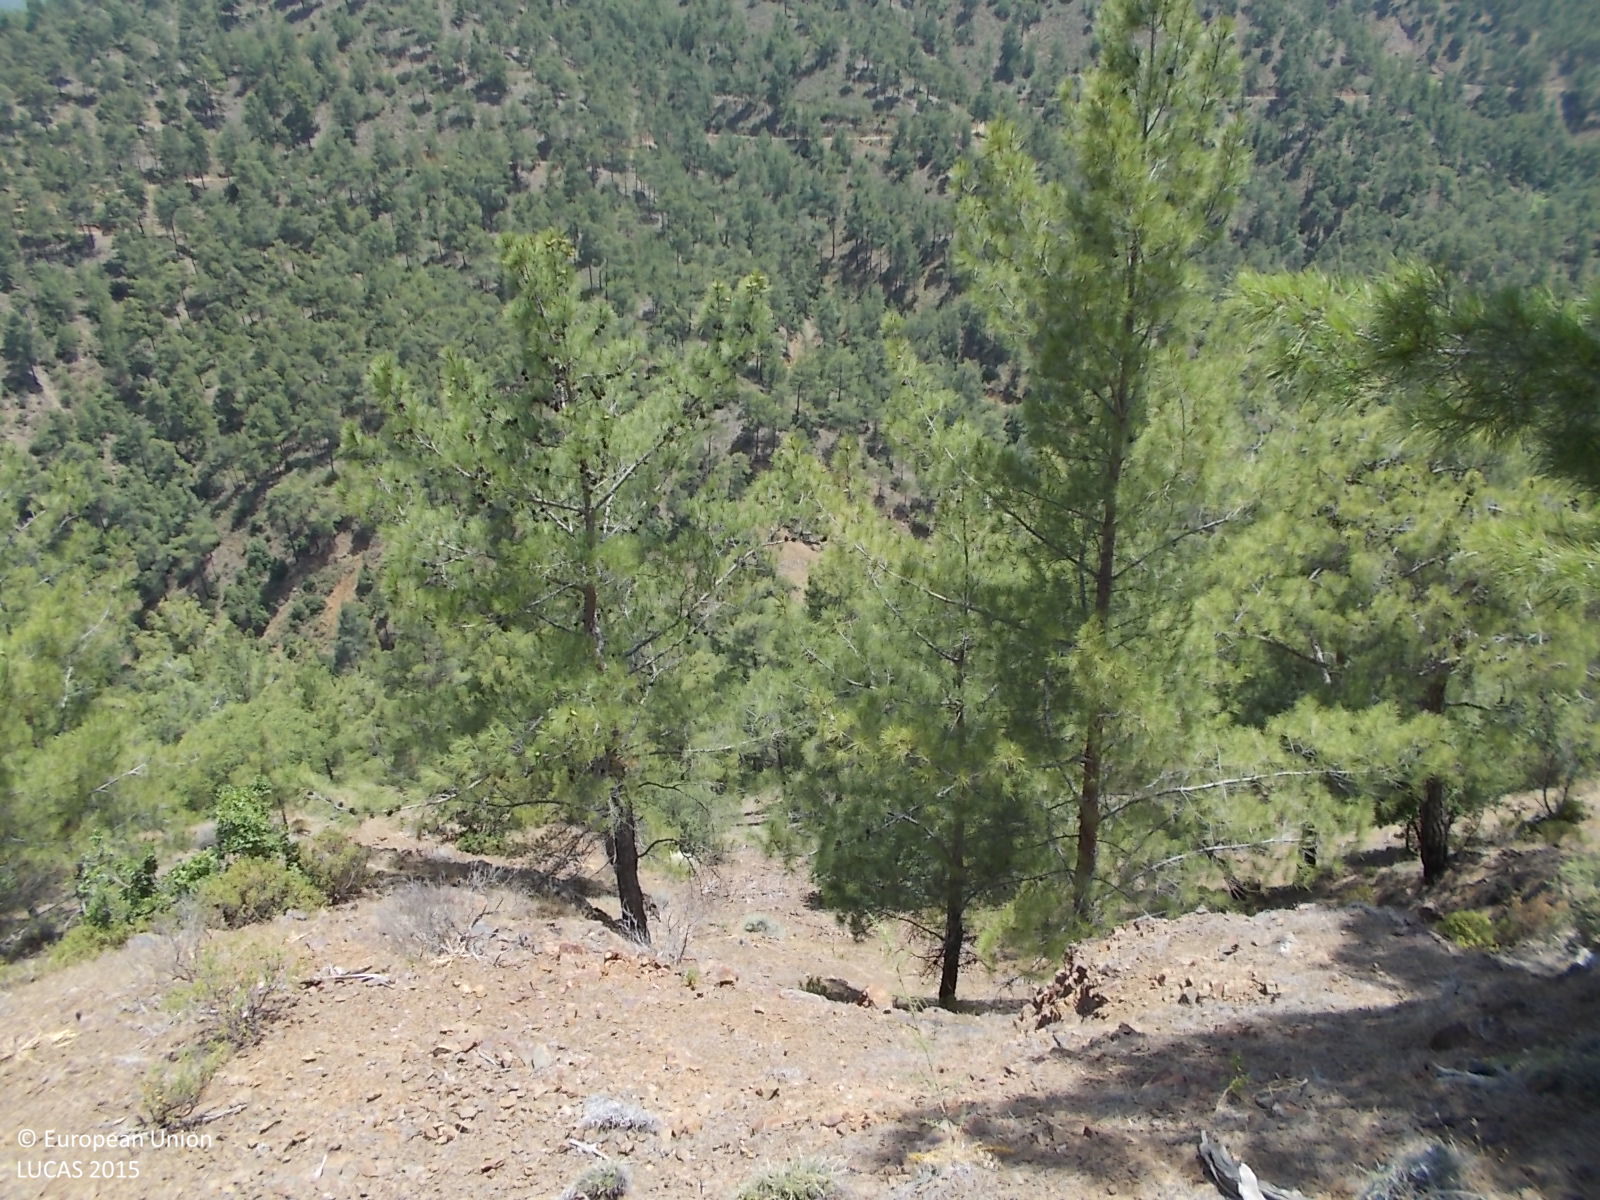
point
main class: Woodland
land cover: Pine dominated coniferous woodland
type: coniferous forest of the mediterranean region
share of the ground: 25 - 50 %
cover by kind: coniferous forest trees 40 %, unconsolidated bare surface 40 %, shrubs 20 %
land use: Forestry
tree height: > 5 m
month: June
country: CY
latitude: 35.1090
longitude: 32.6441
